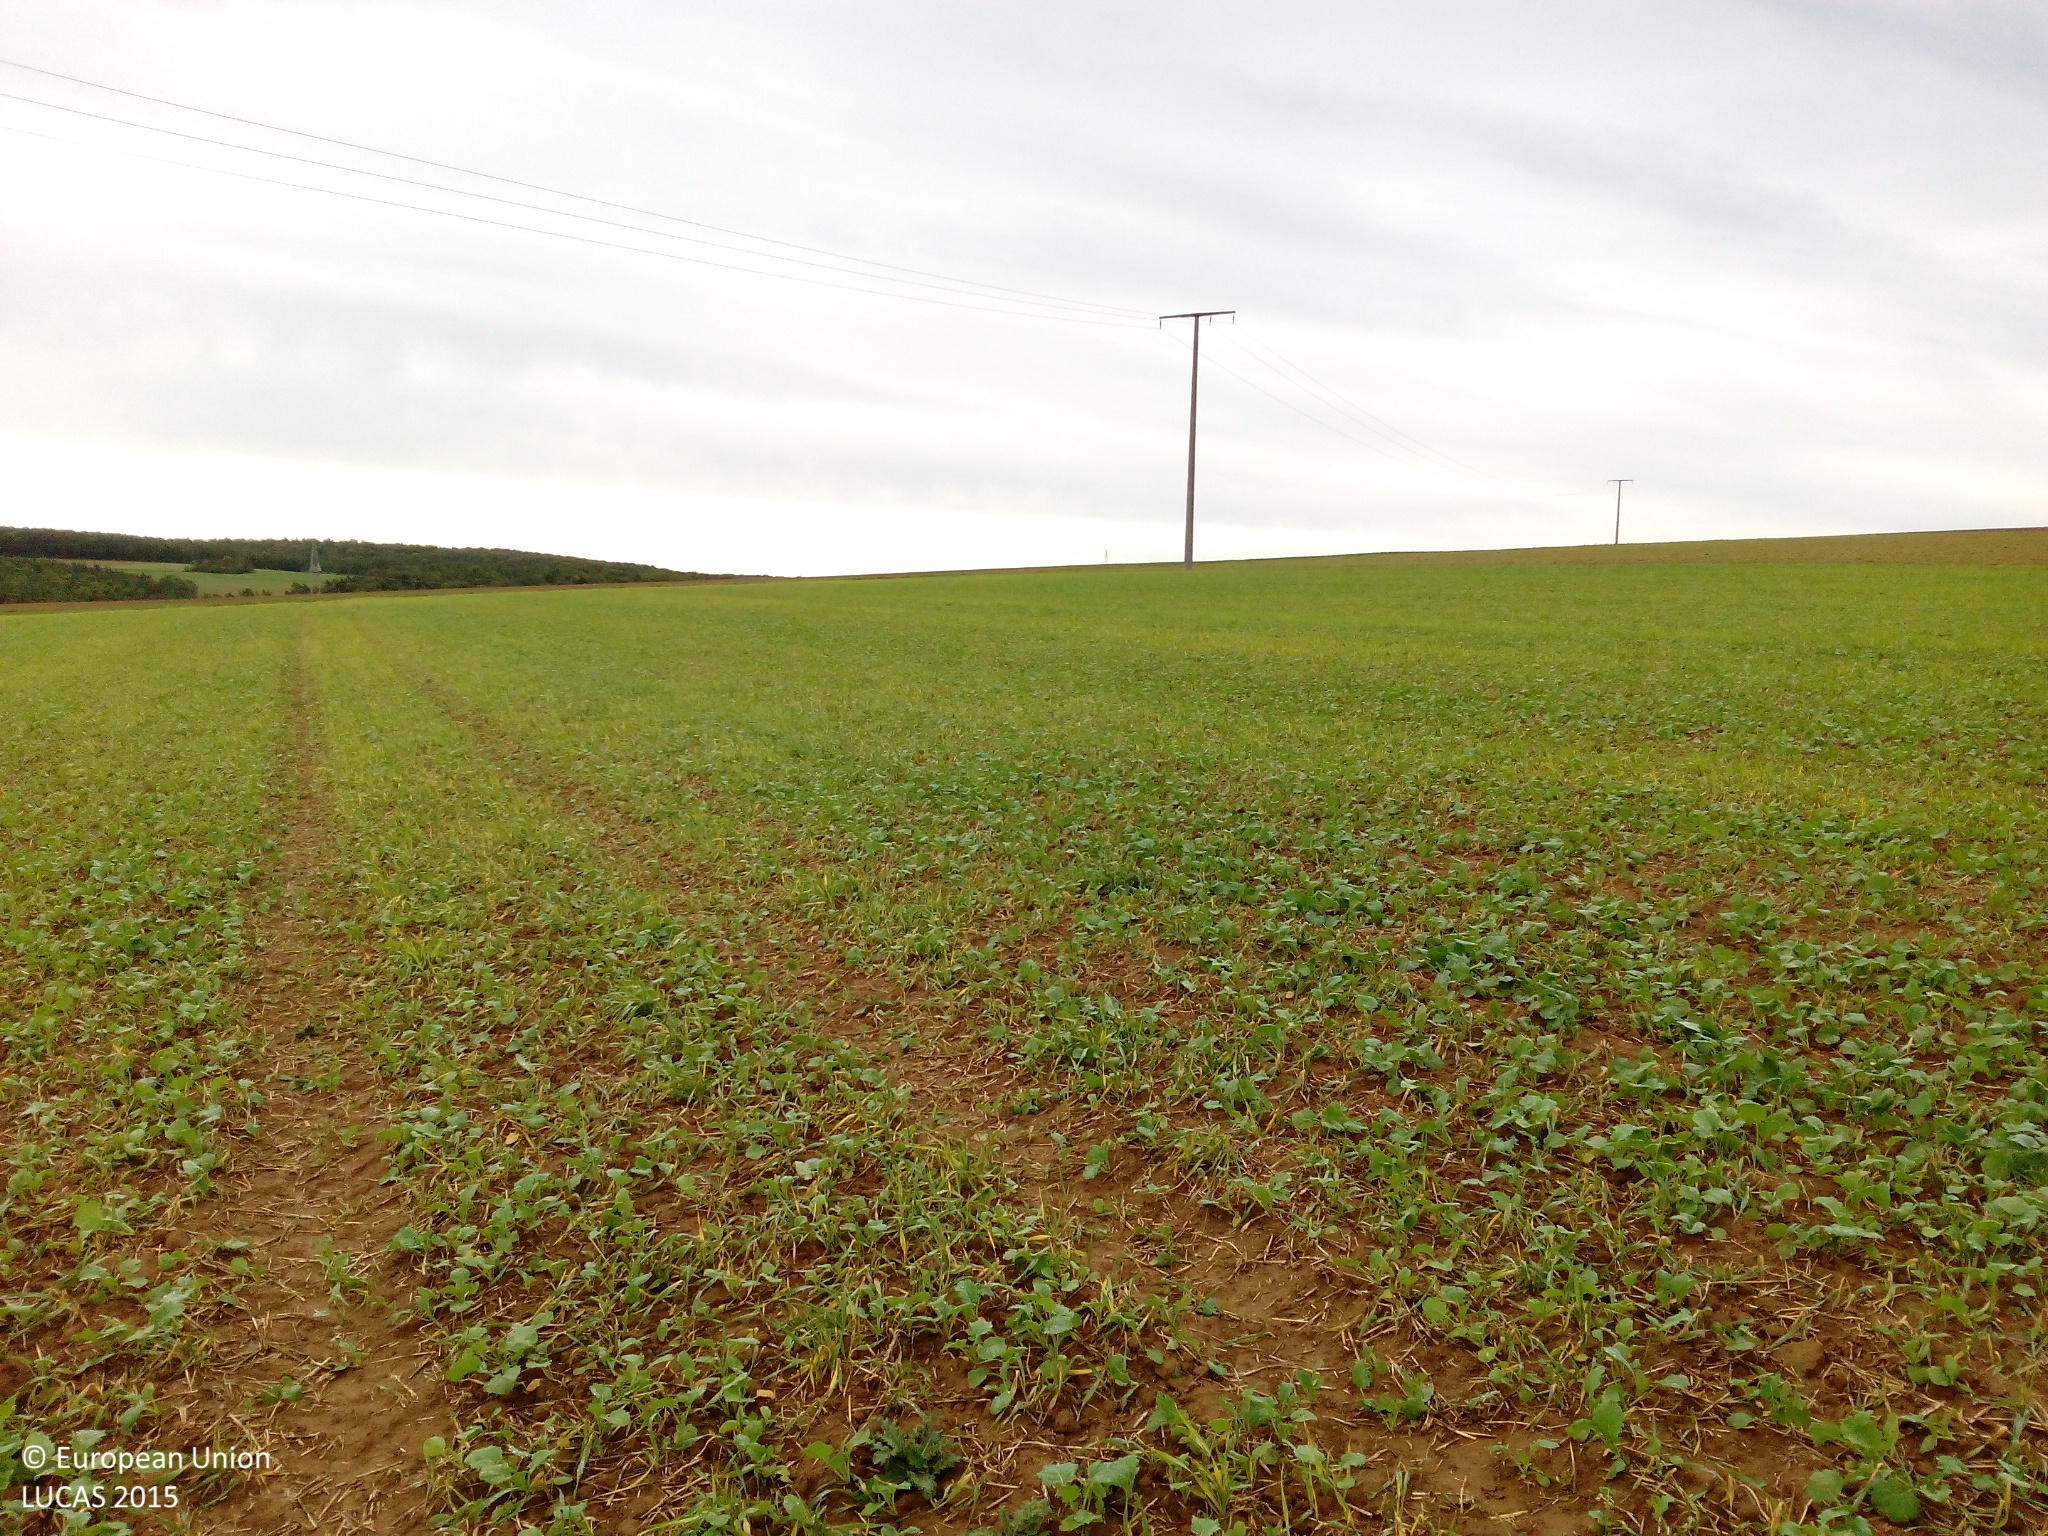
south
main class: Cropland
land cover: Barley
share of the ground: < 10 %
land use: Agriculture (excluding fallow land and kitchen gardens)
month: September
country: DE
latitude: 50.0403
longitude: 9.9023
